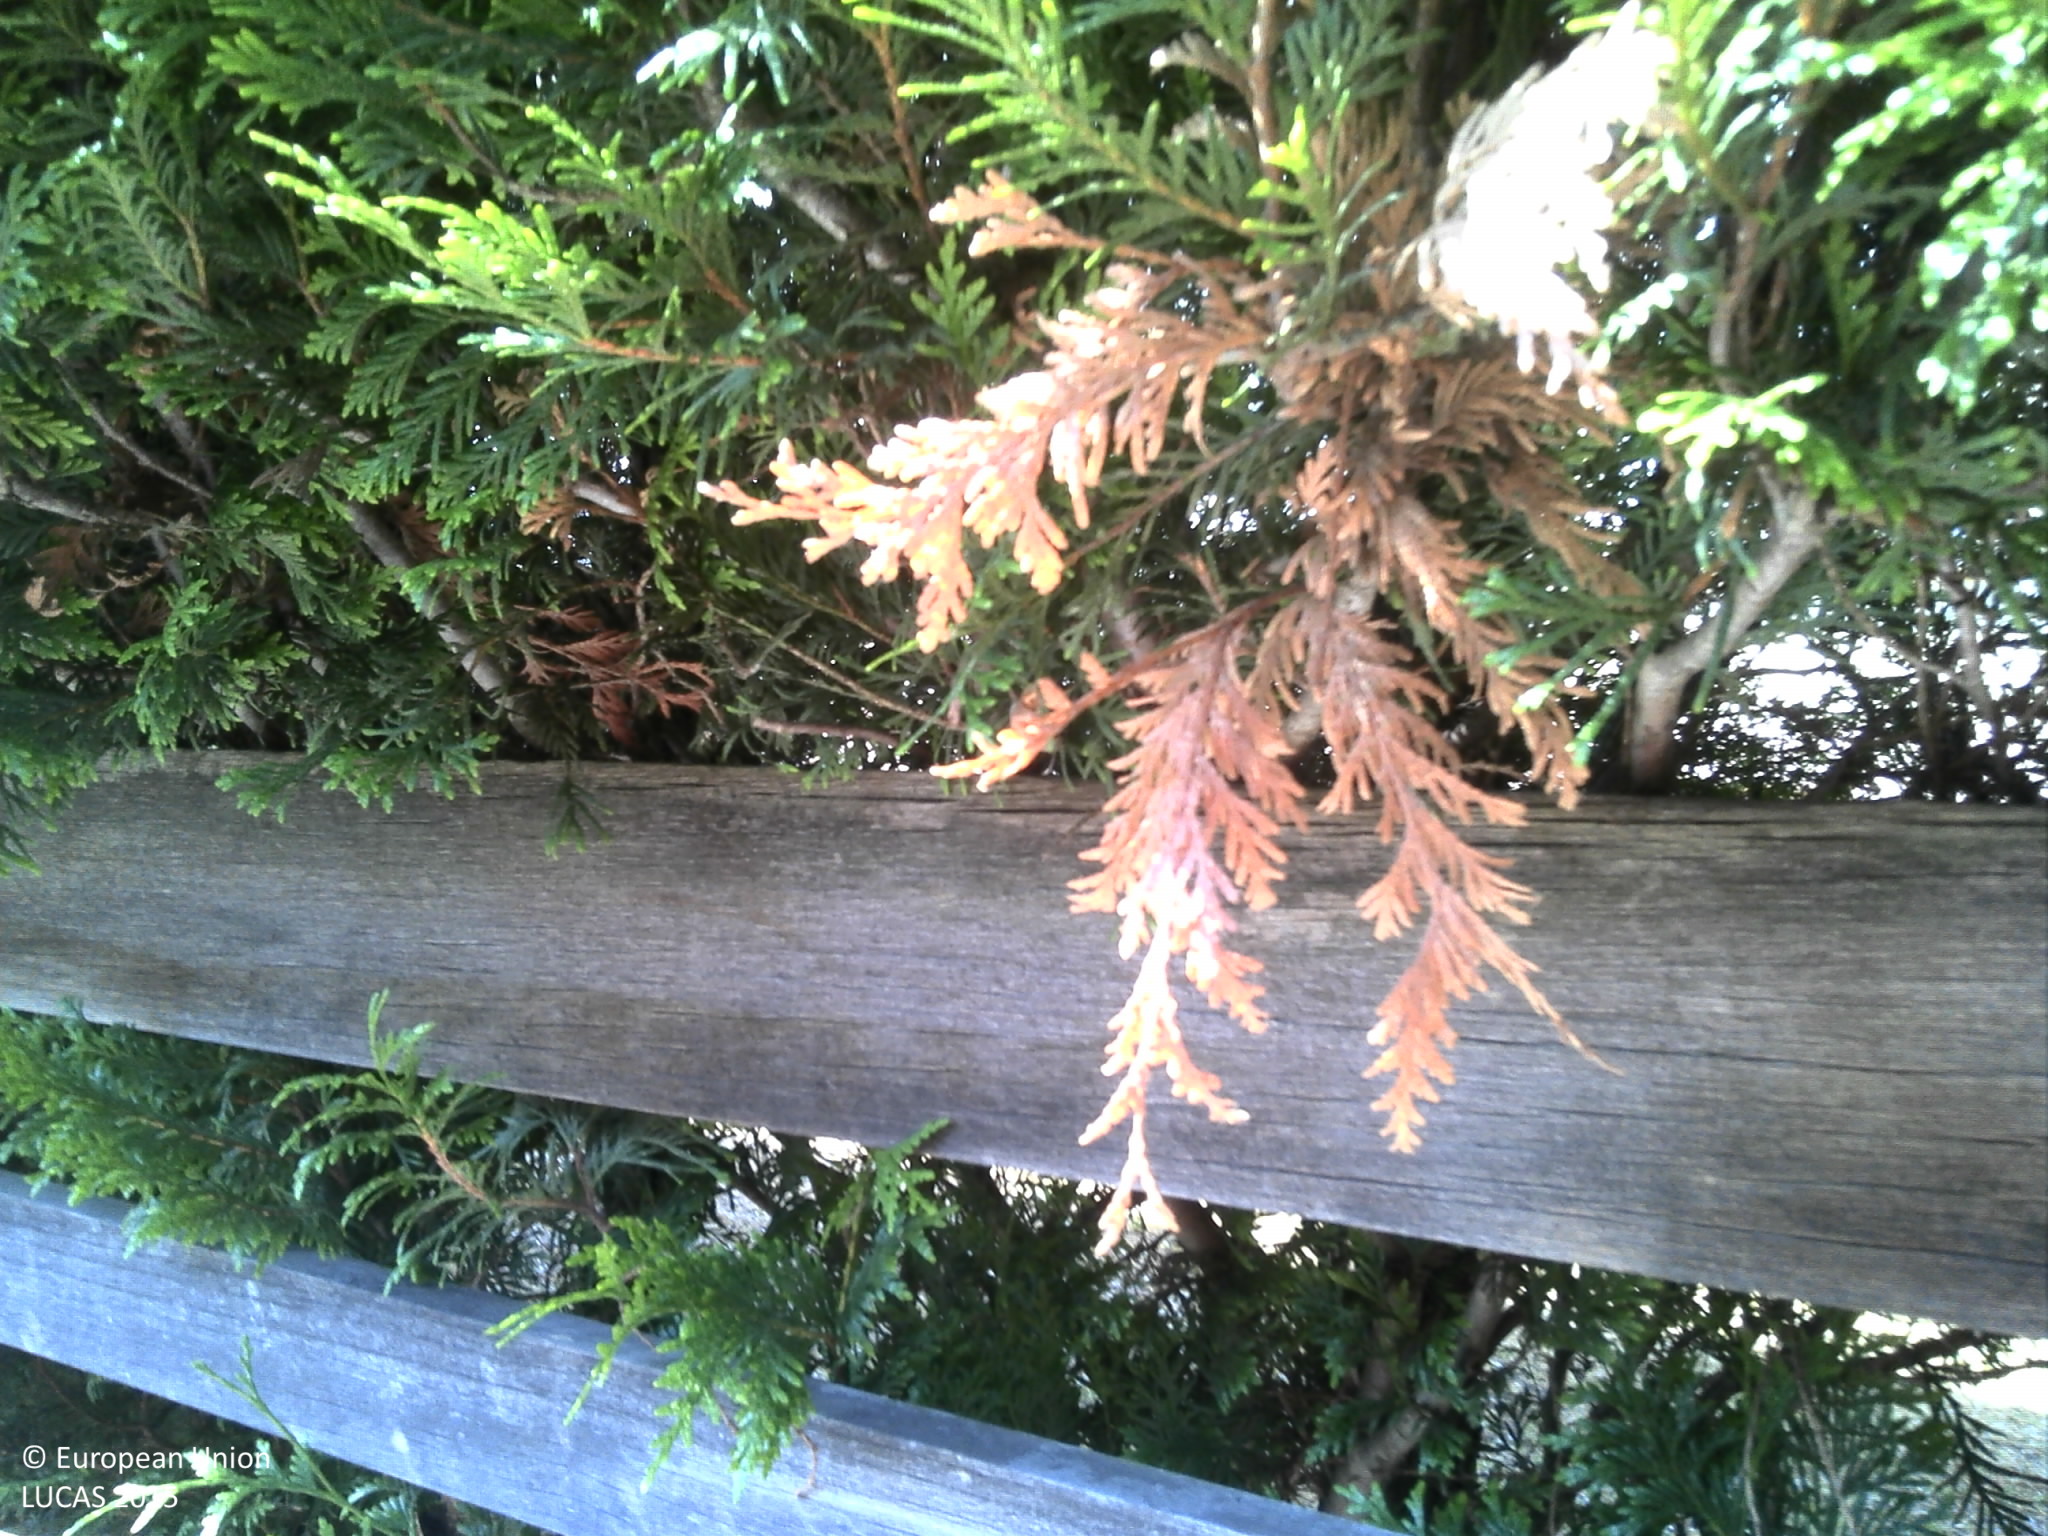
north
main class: Grassland
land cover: Grassland without tree/shrub cover
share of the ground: > 75 %
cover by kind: herbaceous plants 100 %
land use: Residential
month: July
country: FR
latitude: 49.1496
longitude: 6.8058
